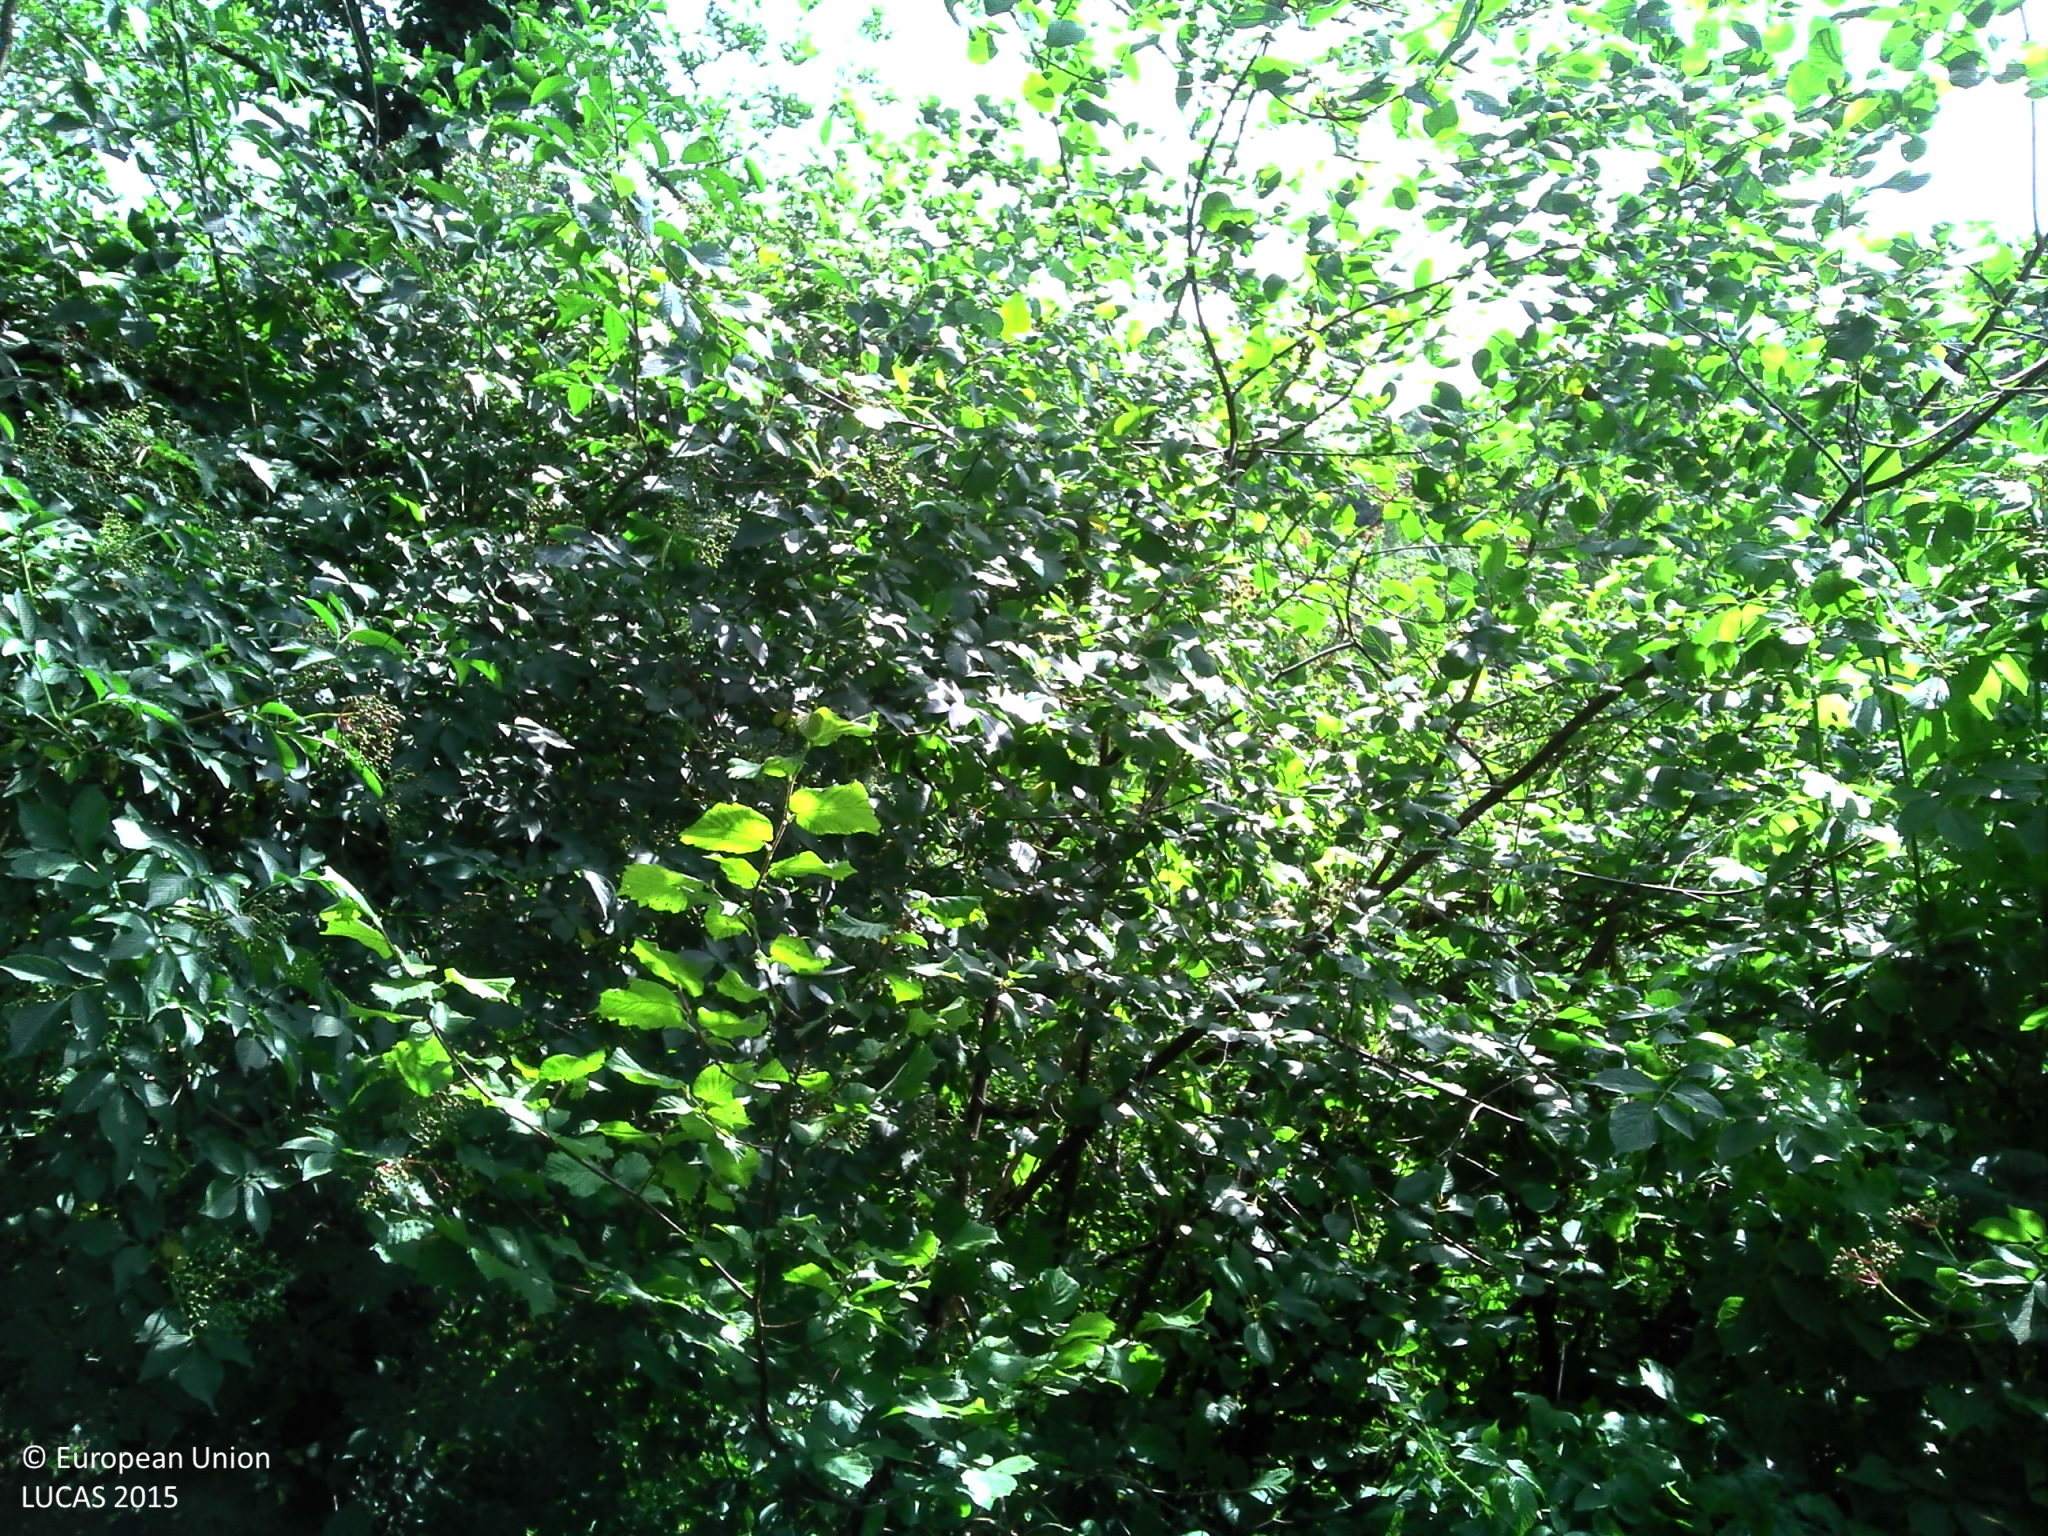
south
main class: Grassland
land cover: Grassland with sparse tree/shrub cover
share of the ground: > 75 %
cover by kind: herbaceous plants 85 %, shrubs 10 %, broadleaved forest trees 5 %
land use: Semi-natural and natural areas not in use
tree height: > 5 m
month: July
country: FR
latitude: 45.5925
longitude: 5.1716
